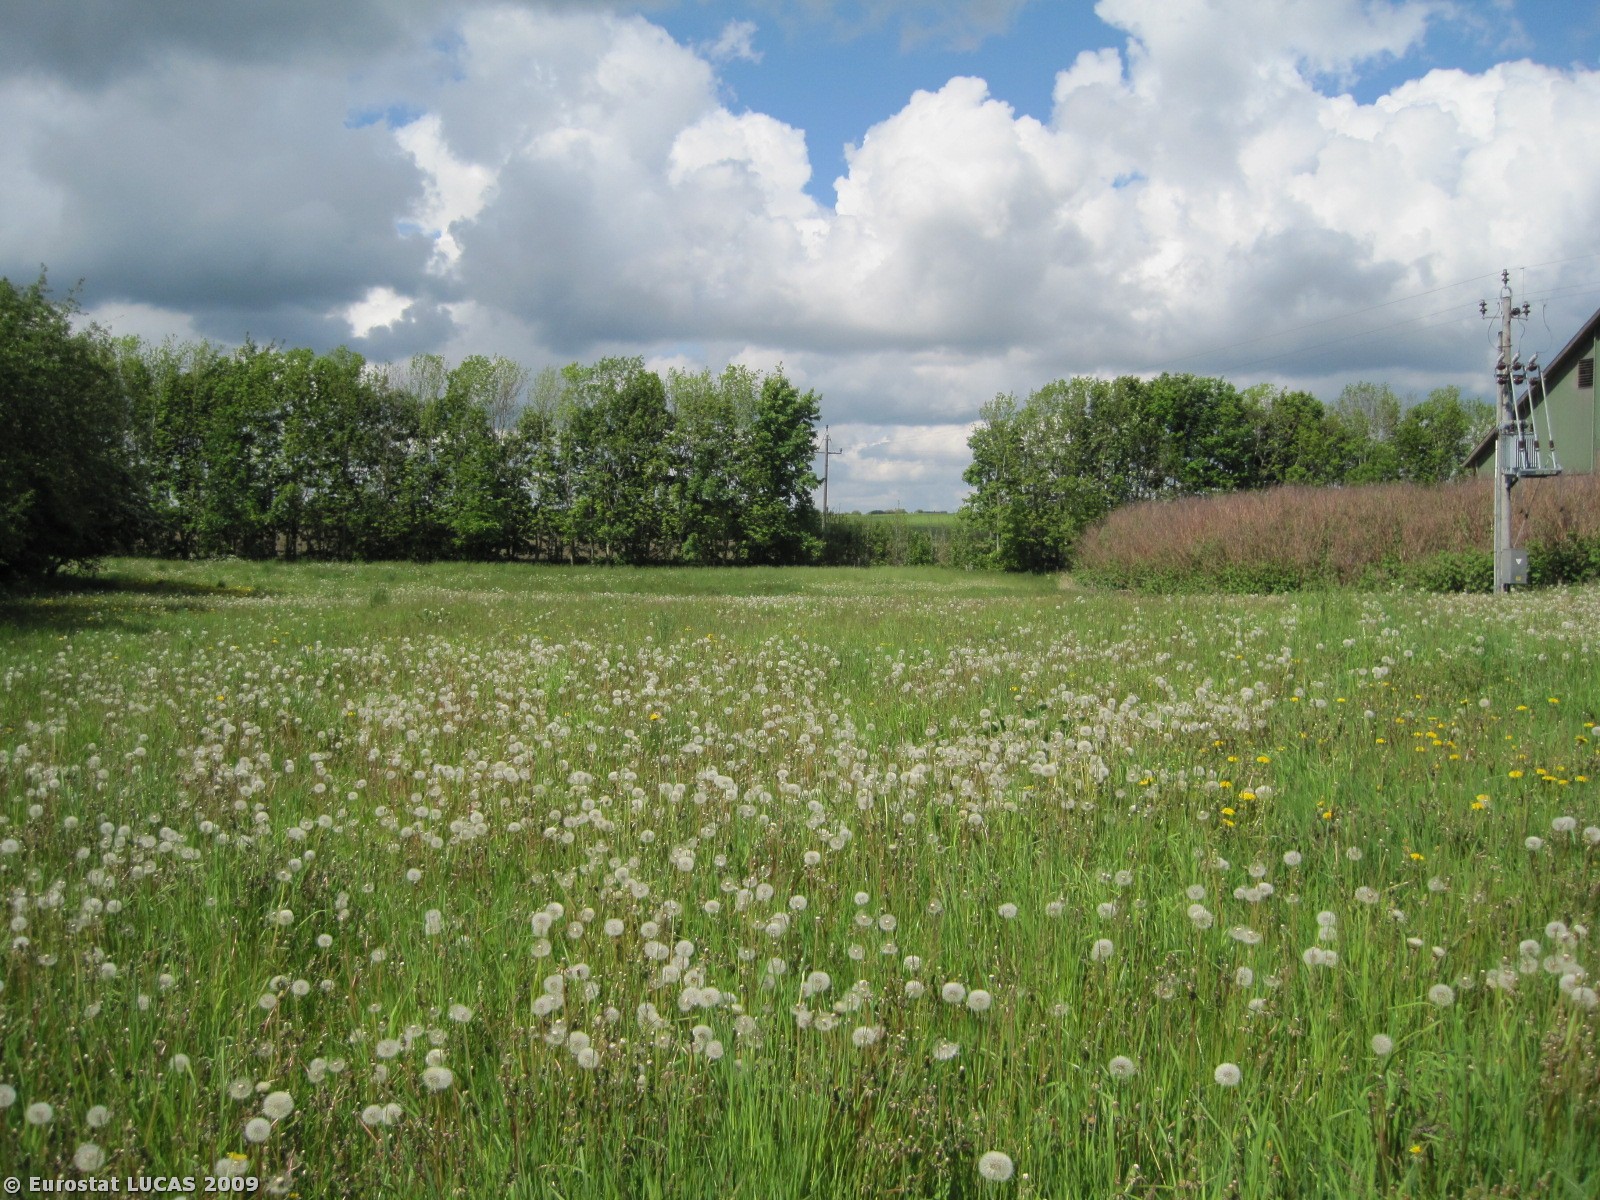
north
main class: Grassland
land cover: Grassland without tree/shrub cover
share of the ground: > 75 %
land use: Agriculture (excluding fallow land and kitchen gardens)
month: May
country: DK
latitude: 56.7269
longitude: 9.8205
